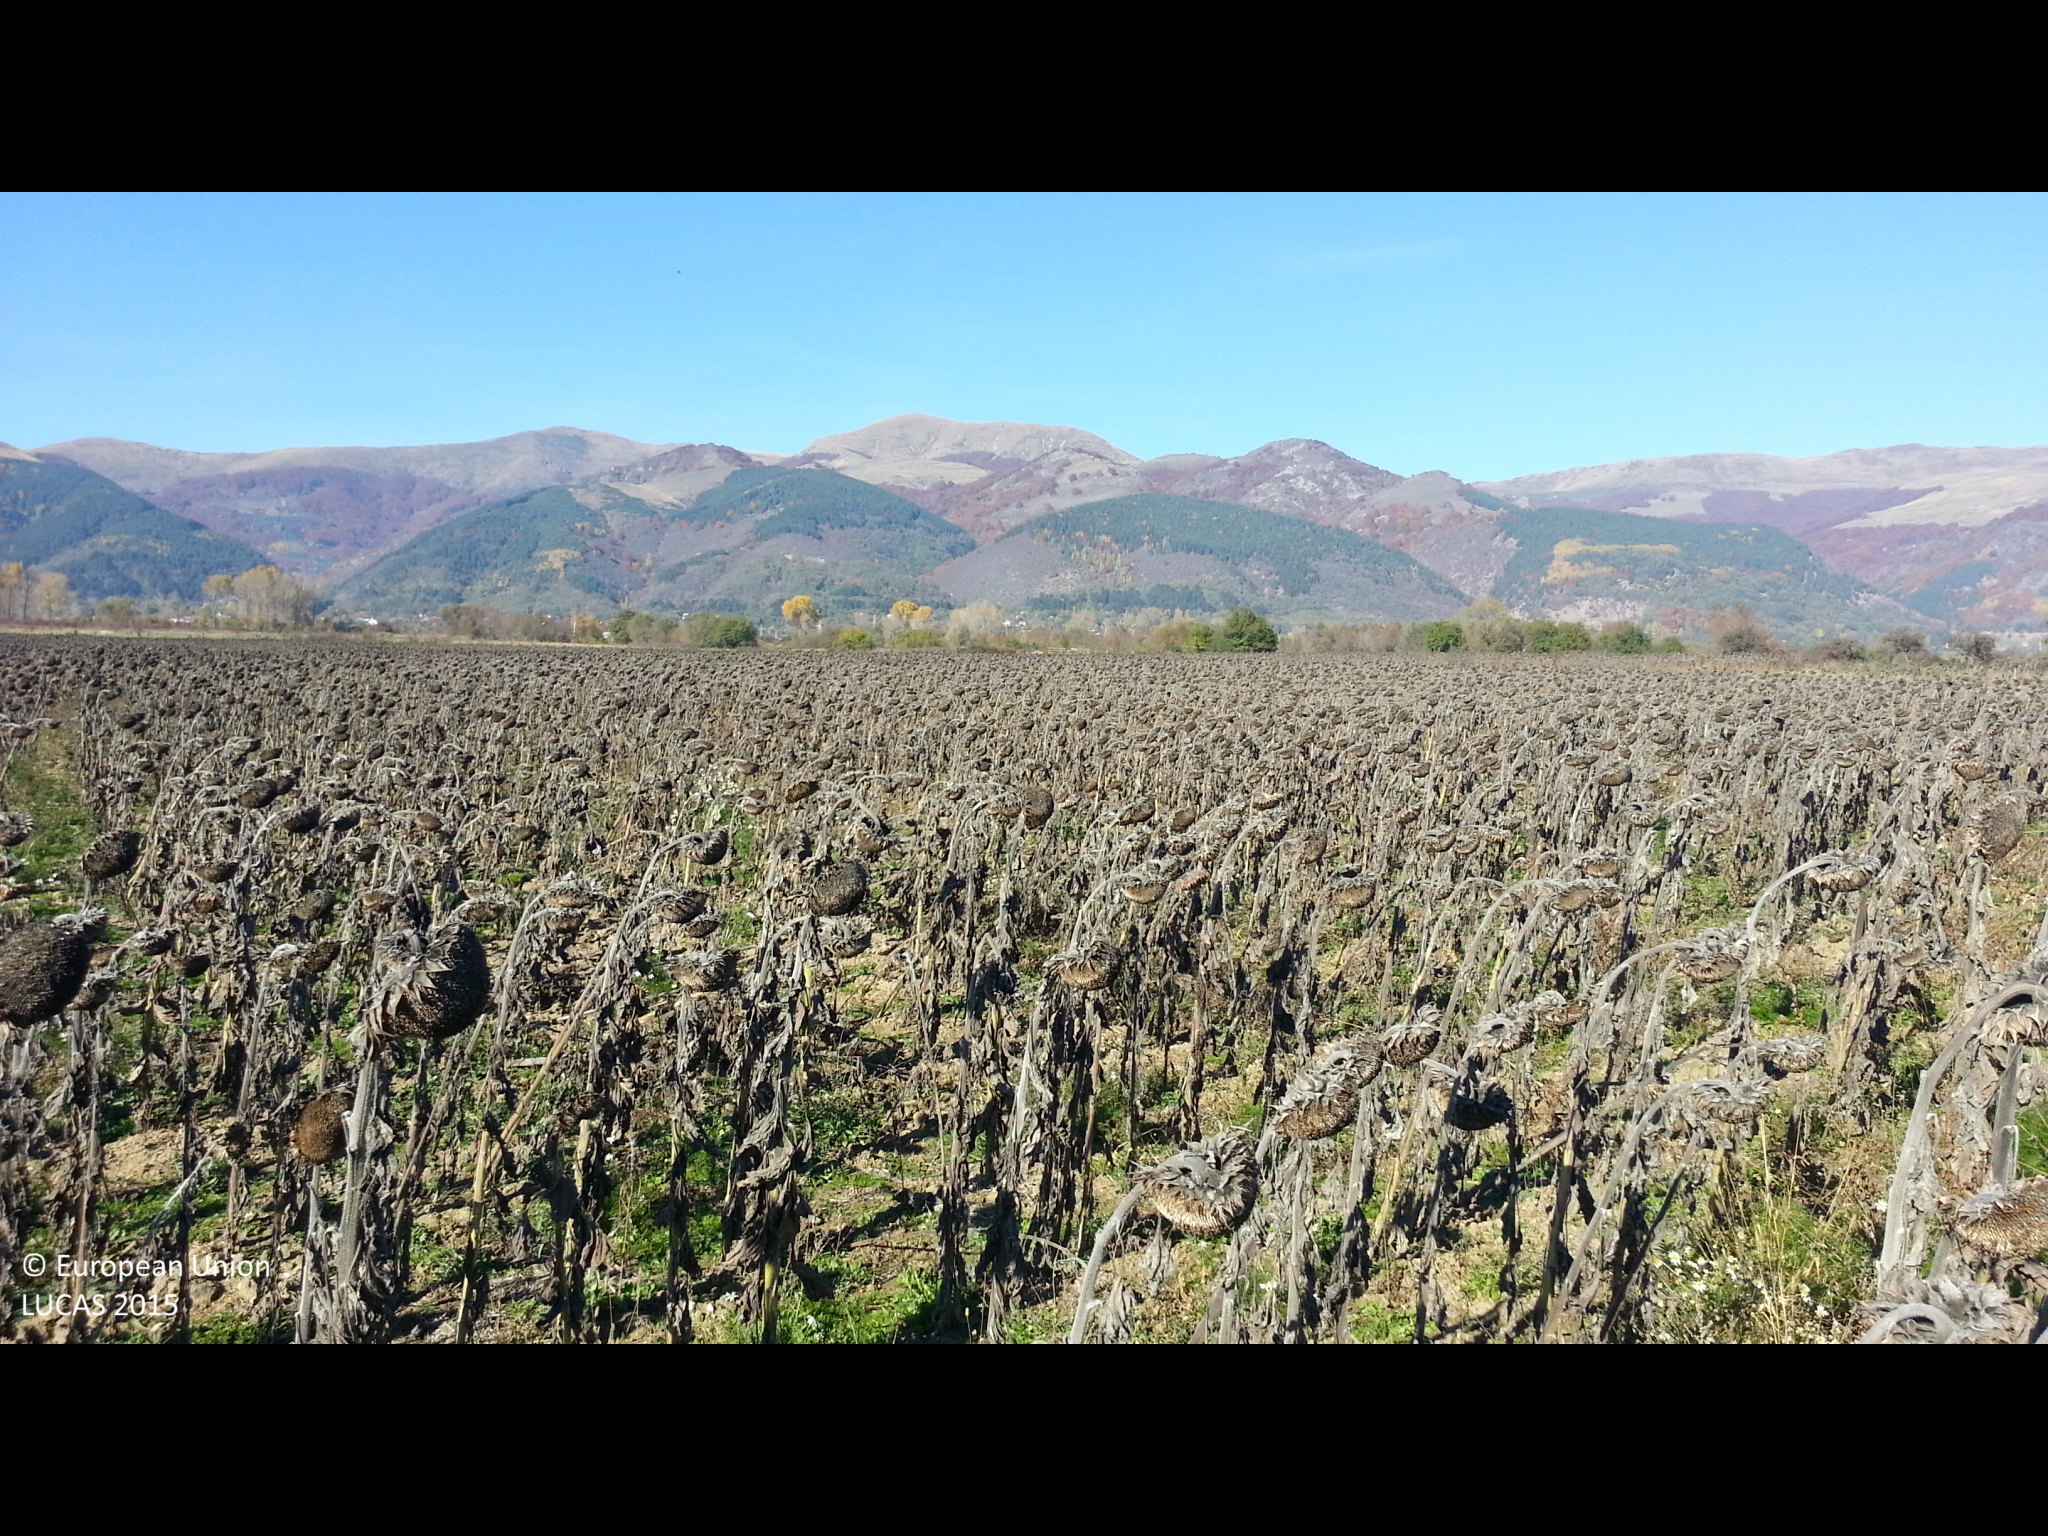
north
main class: Cropland
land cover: Sunflower
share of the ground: 50 - 75 %
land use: Agriculture (excluding fallow land and kitchen gardens)
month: November
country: BG
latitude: 42.7022
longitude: 24.1225
